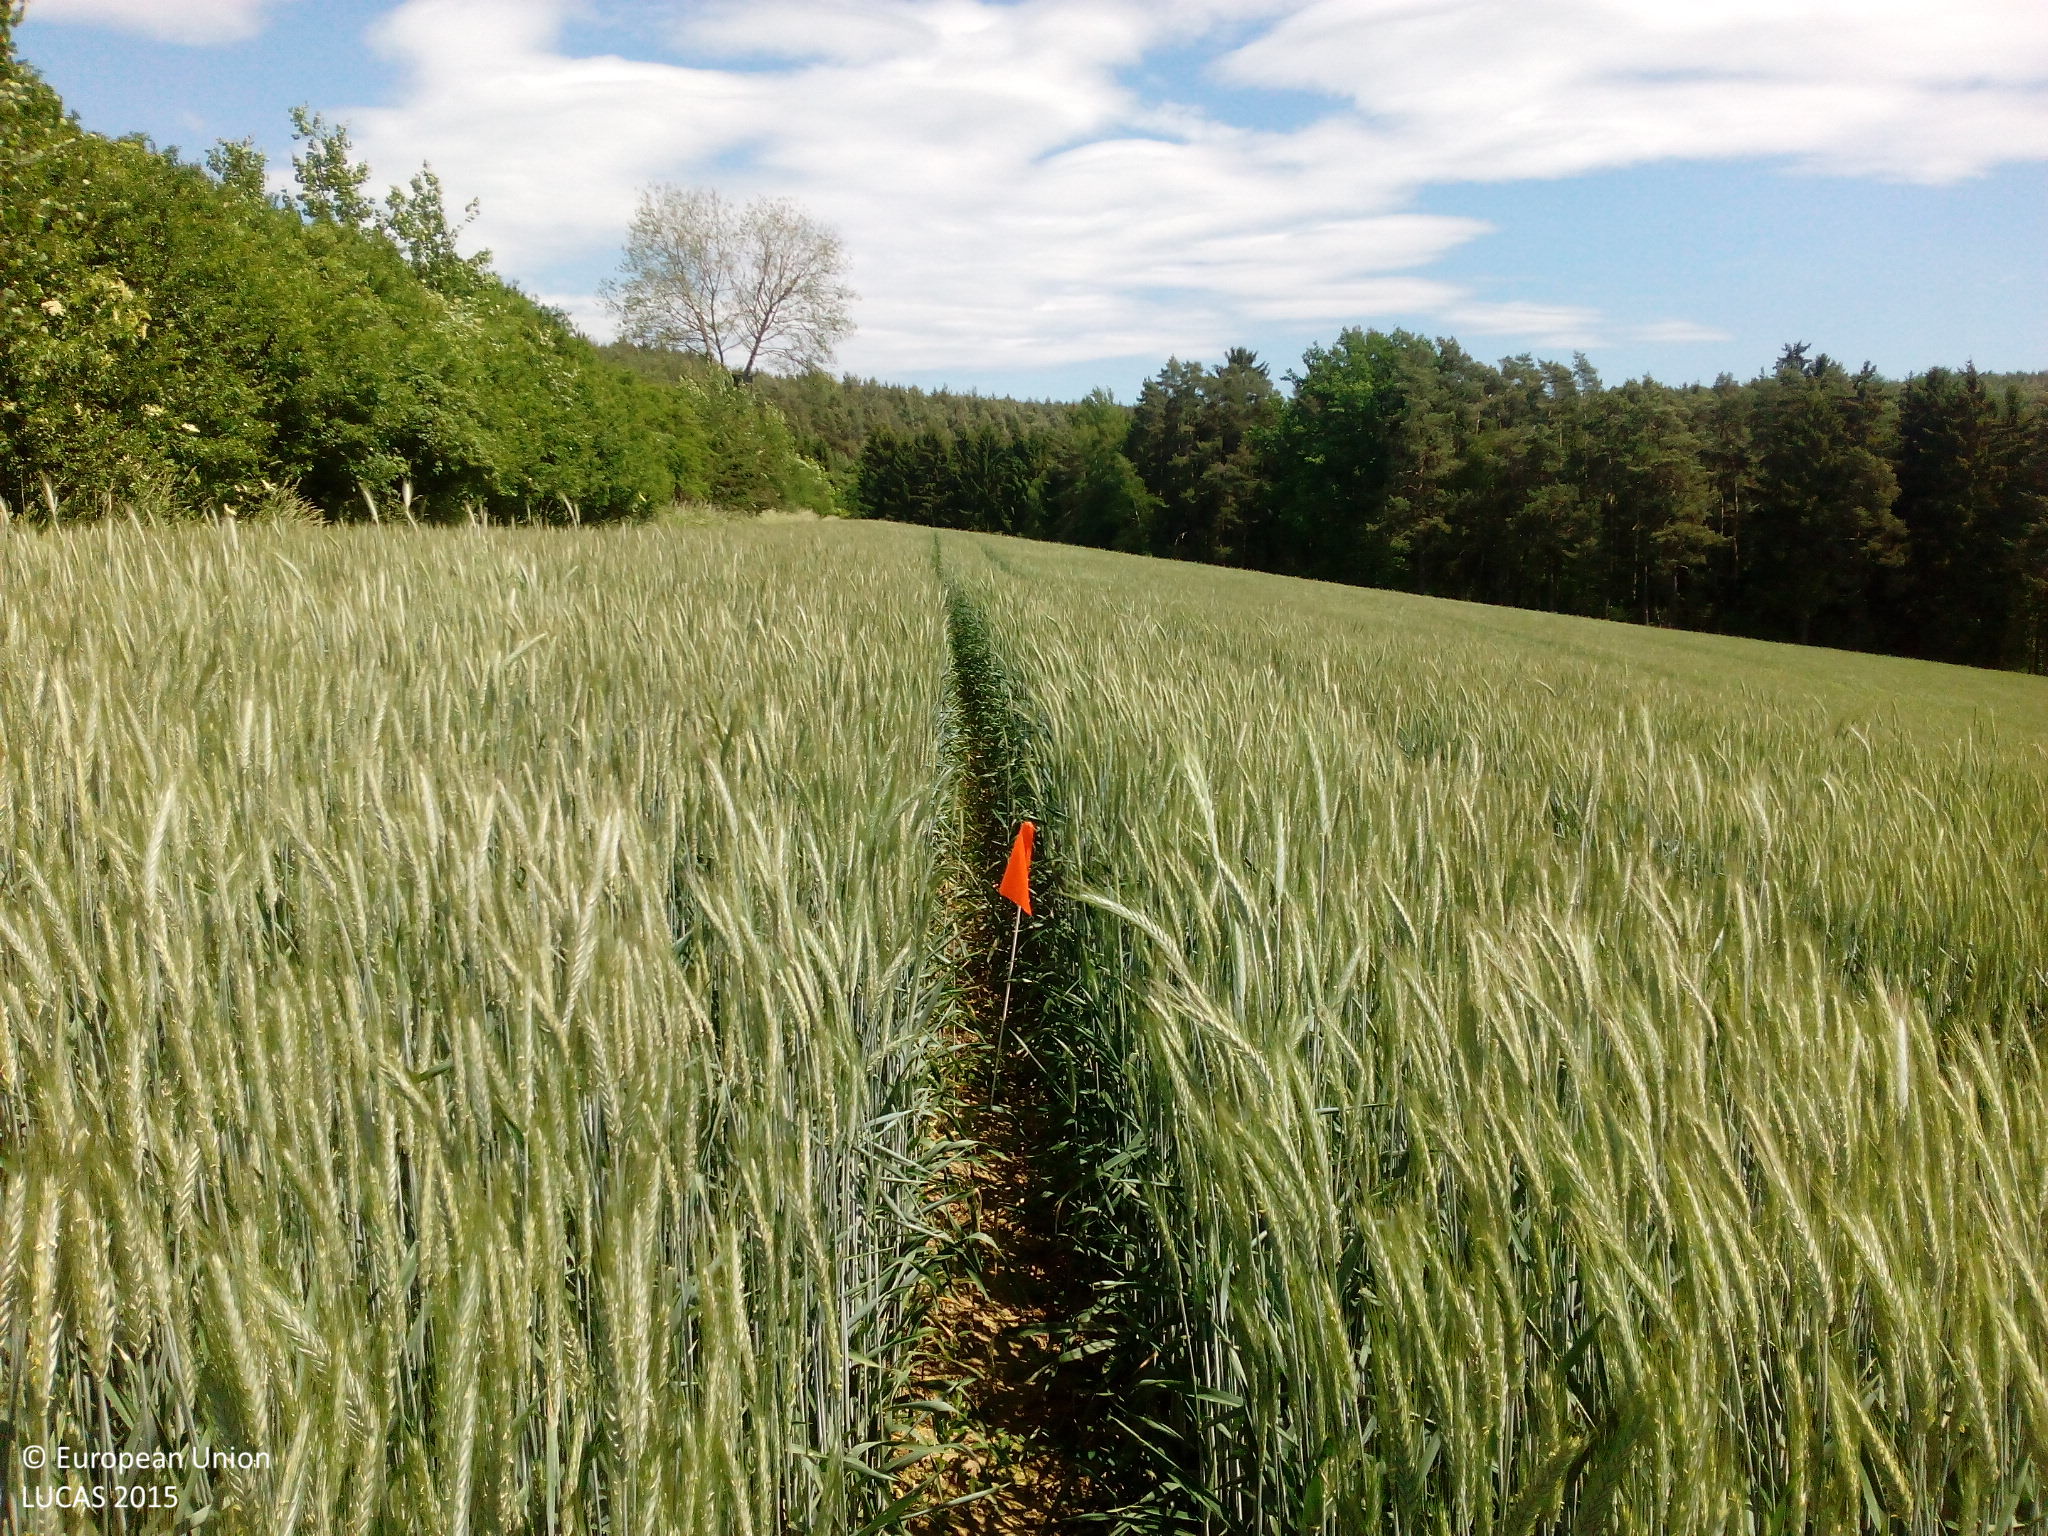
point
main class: Cropland
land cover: Common wheat
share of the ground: > 75 %
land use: Agriculture (excluding fallow land and kitchen gardens)
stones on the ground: 10 - 25 %
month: June
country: DE
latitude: 49.4250
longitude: 12.2192
